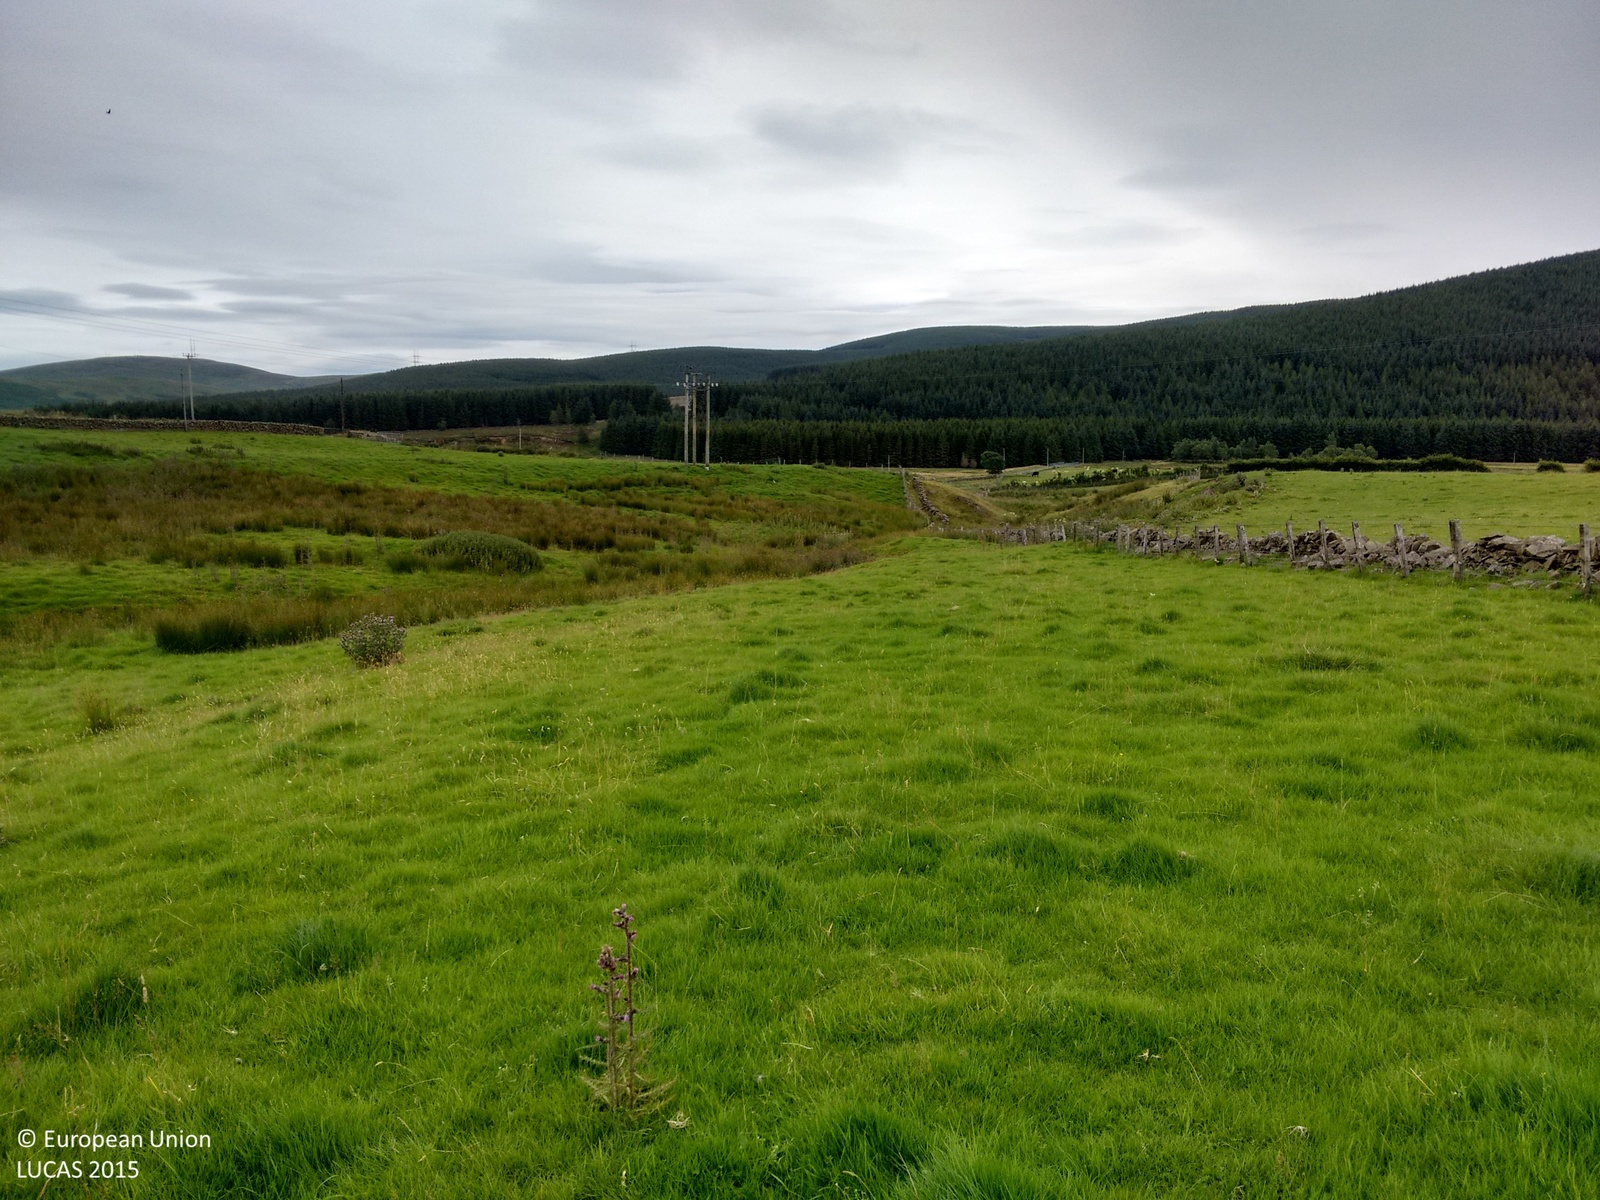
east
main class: Grassland
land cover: Grassland without tree/shrub cover
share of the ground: 50 - 75 %
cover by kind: herbaceous plants 95 %, lichens and mosses 5 %
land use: Agriculture (excluding fallow land and kitchen gardens)
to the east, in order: Grassland without tree/shrub cover; Rivers and streams; Grassland without tree/shrub cover; Electric lines; Grassland without tree/shrub cover; Dry stone walls; Grass margins; Electric lines; Paved roads, cycling and walking lanes; Grass margins; Dry stone walls; Grassland without tree/shrub cover; Electric lines; Grassland without tree/shrub cover
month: August
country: GB
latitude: 55.4946
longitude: -3.7762
